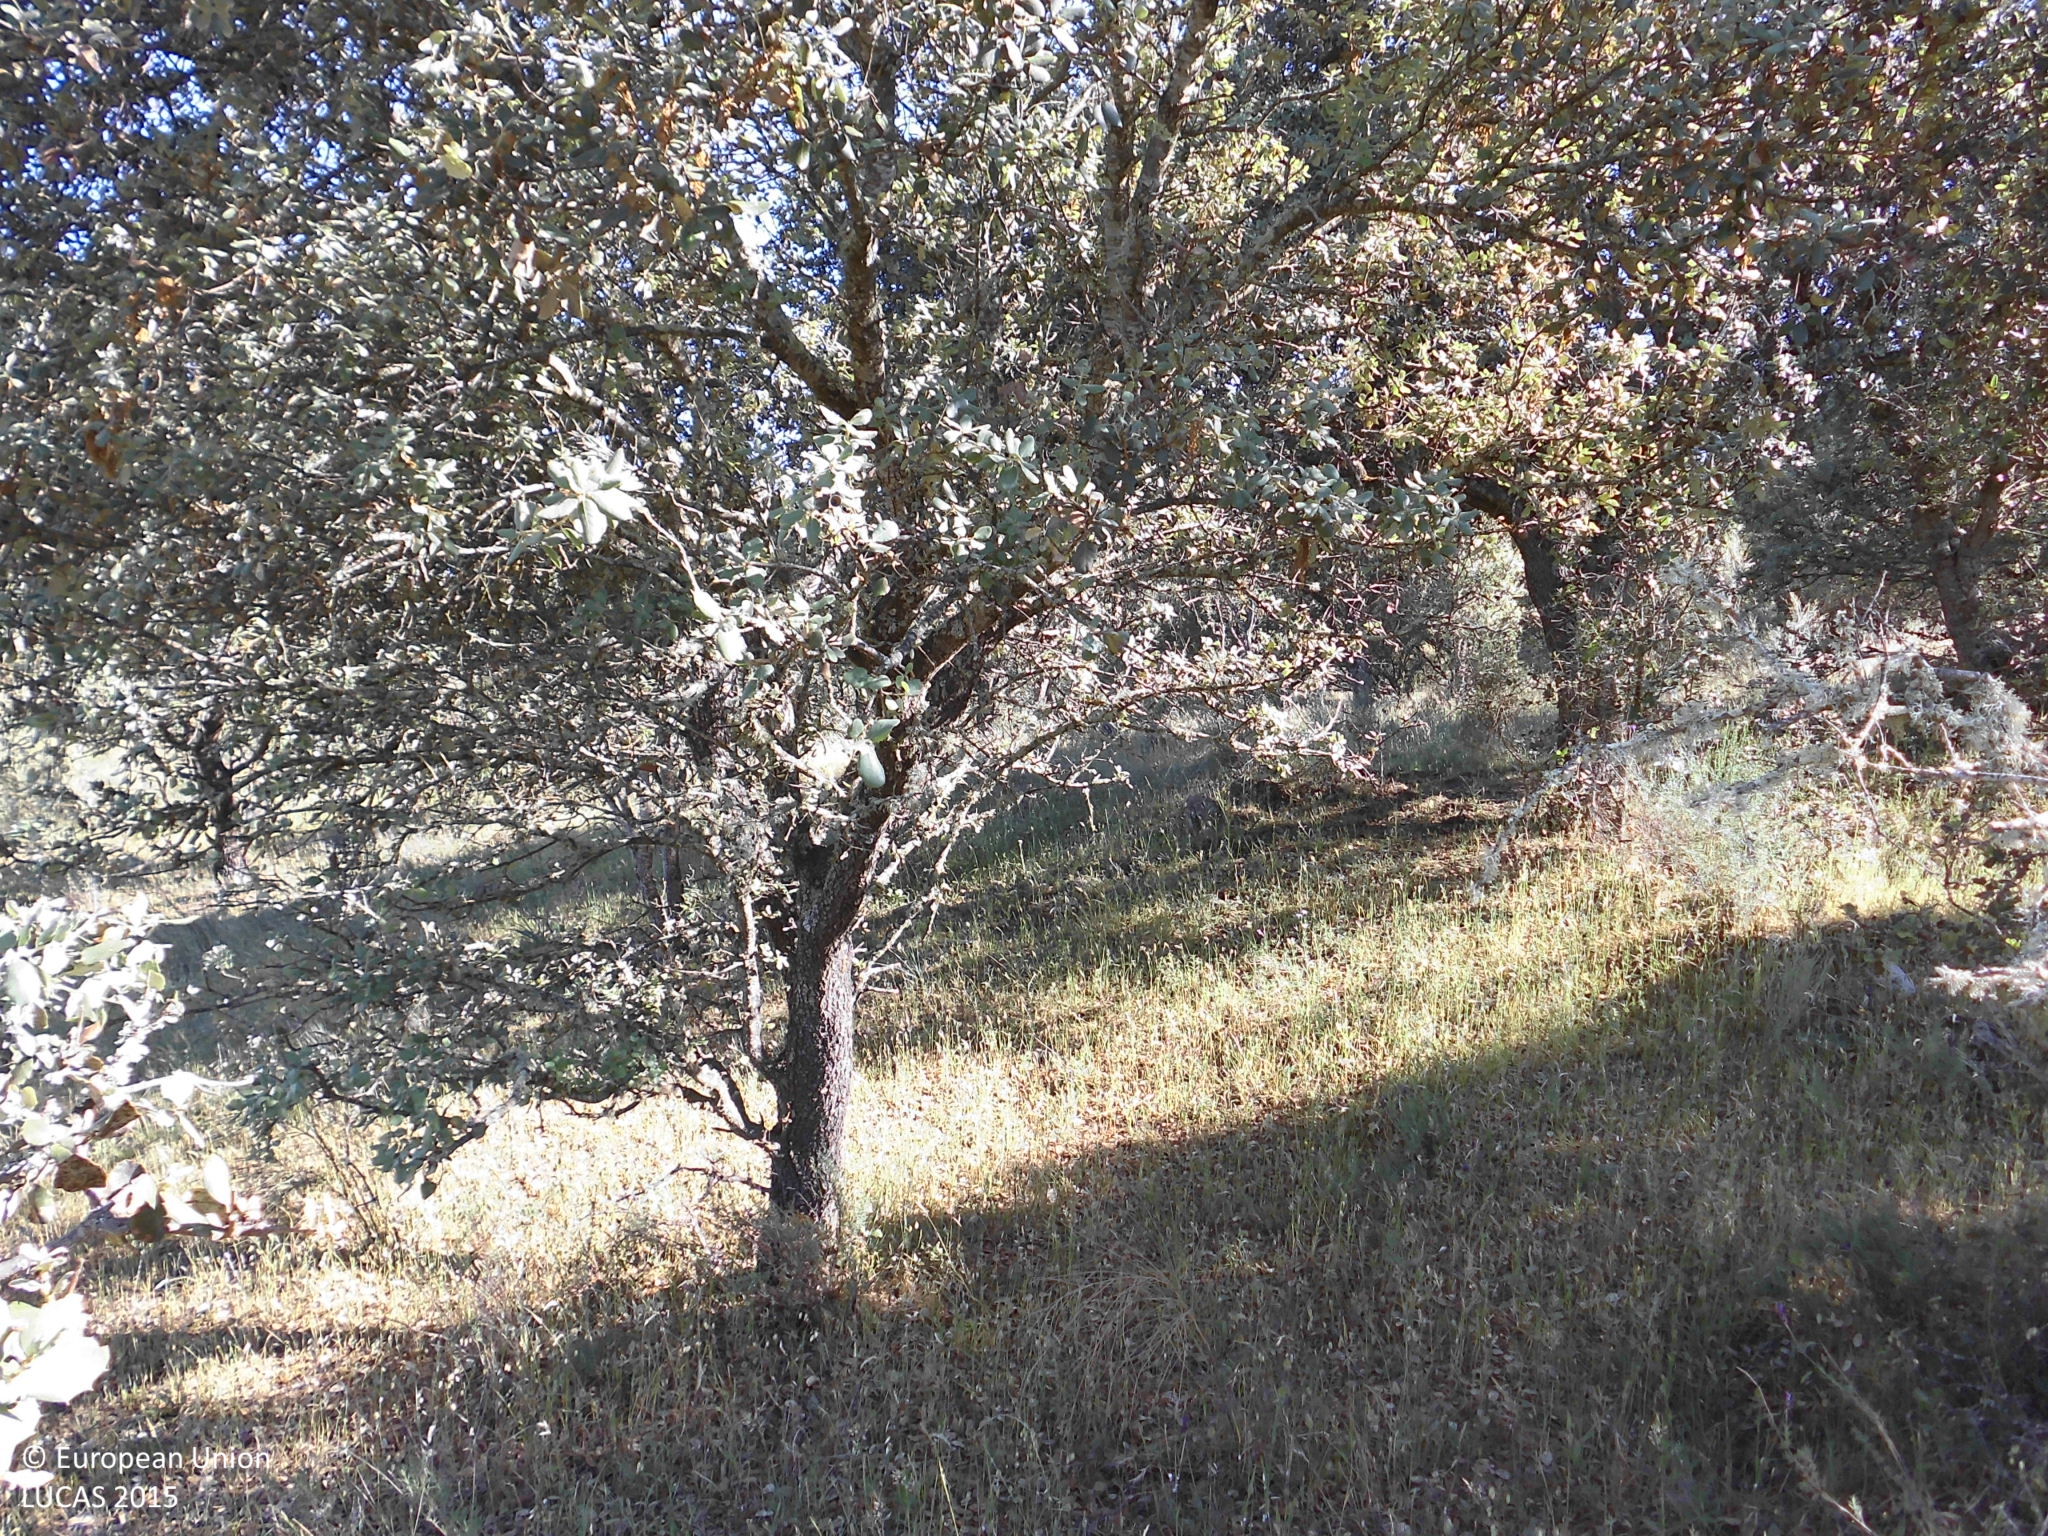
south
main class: Woodland
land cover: Broadleaved woodland
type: broadleaved evergreen forest
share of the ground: 25 - 50 %
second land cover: Grassland without tree/shrub cover
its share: > 75 %
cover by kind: herbaceous plants 55 %, broadleaved forest trees 40 %, shrubs 5 %
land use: Forestry
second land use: Agriculture (excluding fallow land and kitchen gardens)
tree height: > 5 m
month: May
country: ES
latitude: 39.5201
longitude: -6.0806
